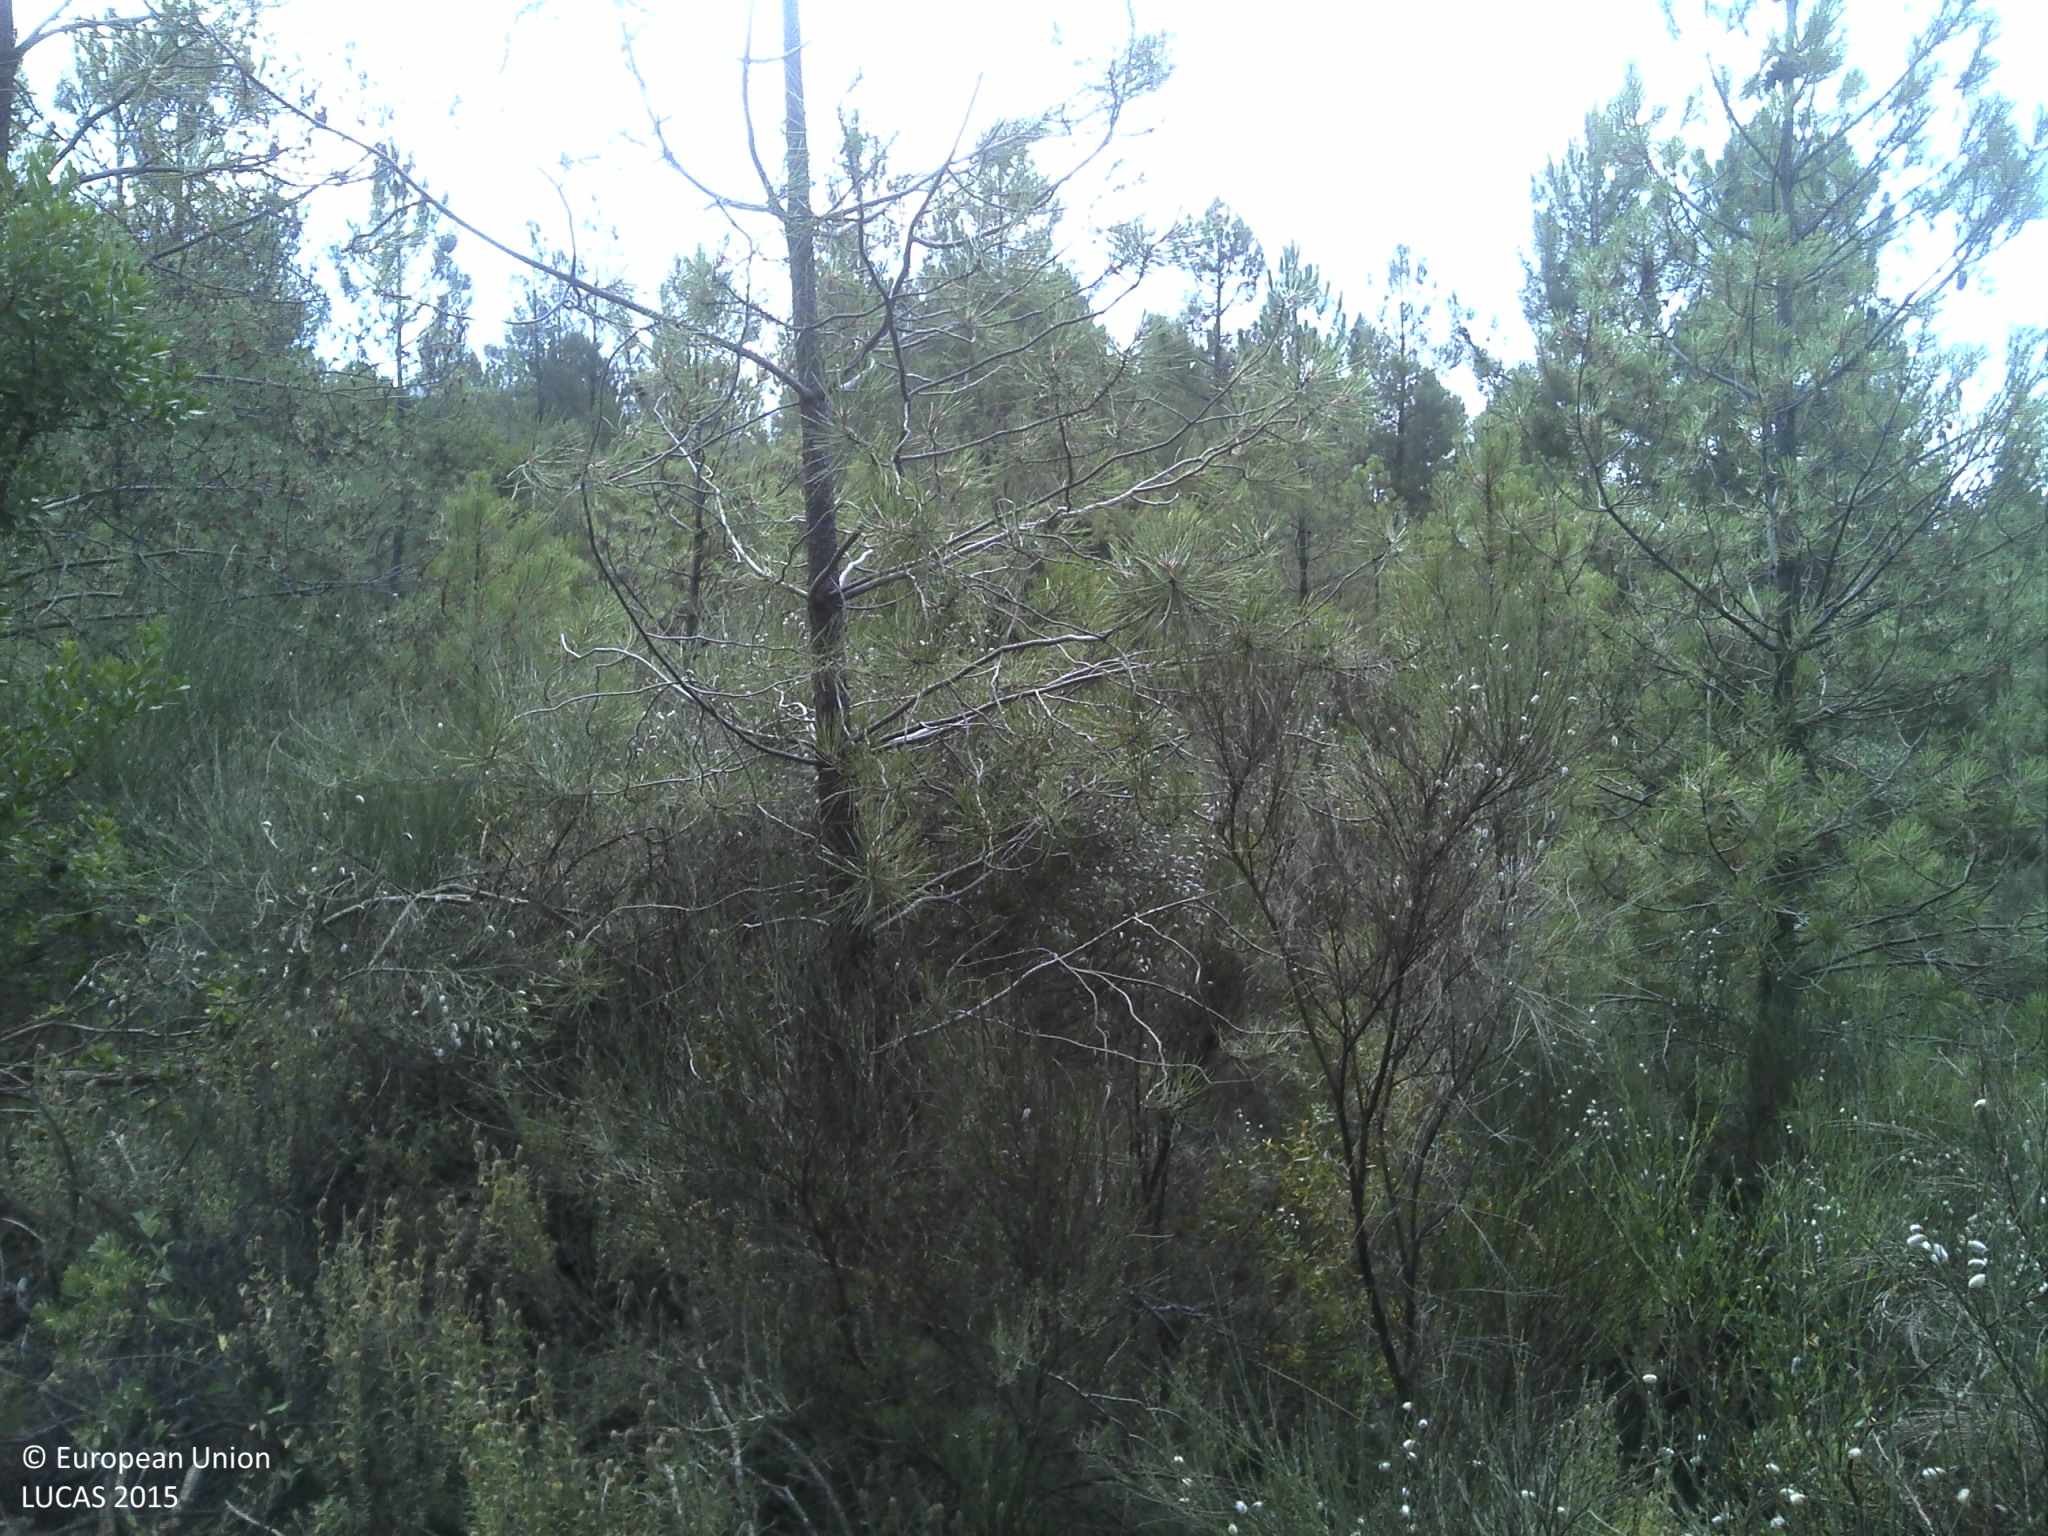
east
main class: Woodland
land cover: Pine dominated coniferous woodland
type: coniferous forest of the mediterranean region
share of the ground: 25 - 50 %
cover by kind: coniferous forest trees 45 %, shrubs 35 %, unconsolidated bare surface 20 %
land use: Forestry
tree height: > 5 m
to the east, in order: Pine dominated coniferous woodland; Tracks; Shrubland without tree cover; Broadleaved woodland; Shrubland without tree cover; Tracks; Broadleaved woodland
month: June
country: PT
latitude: 40.1986
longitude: -7.1666
